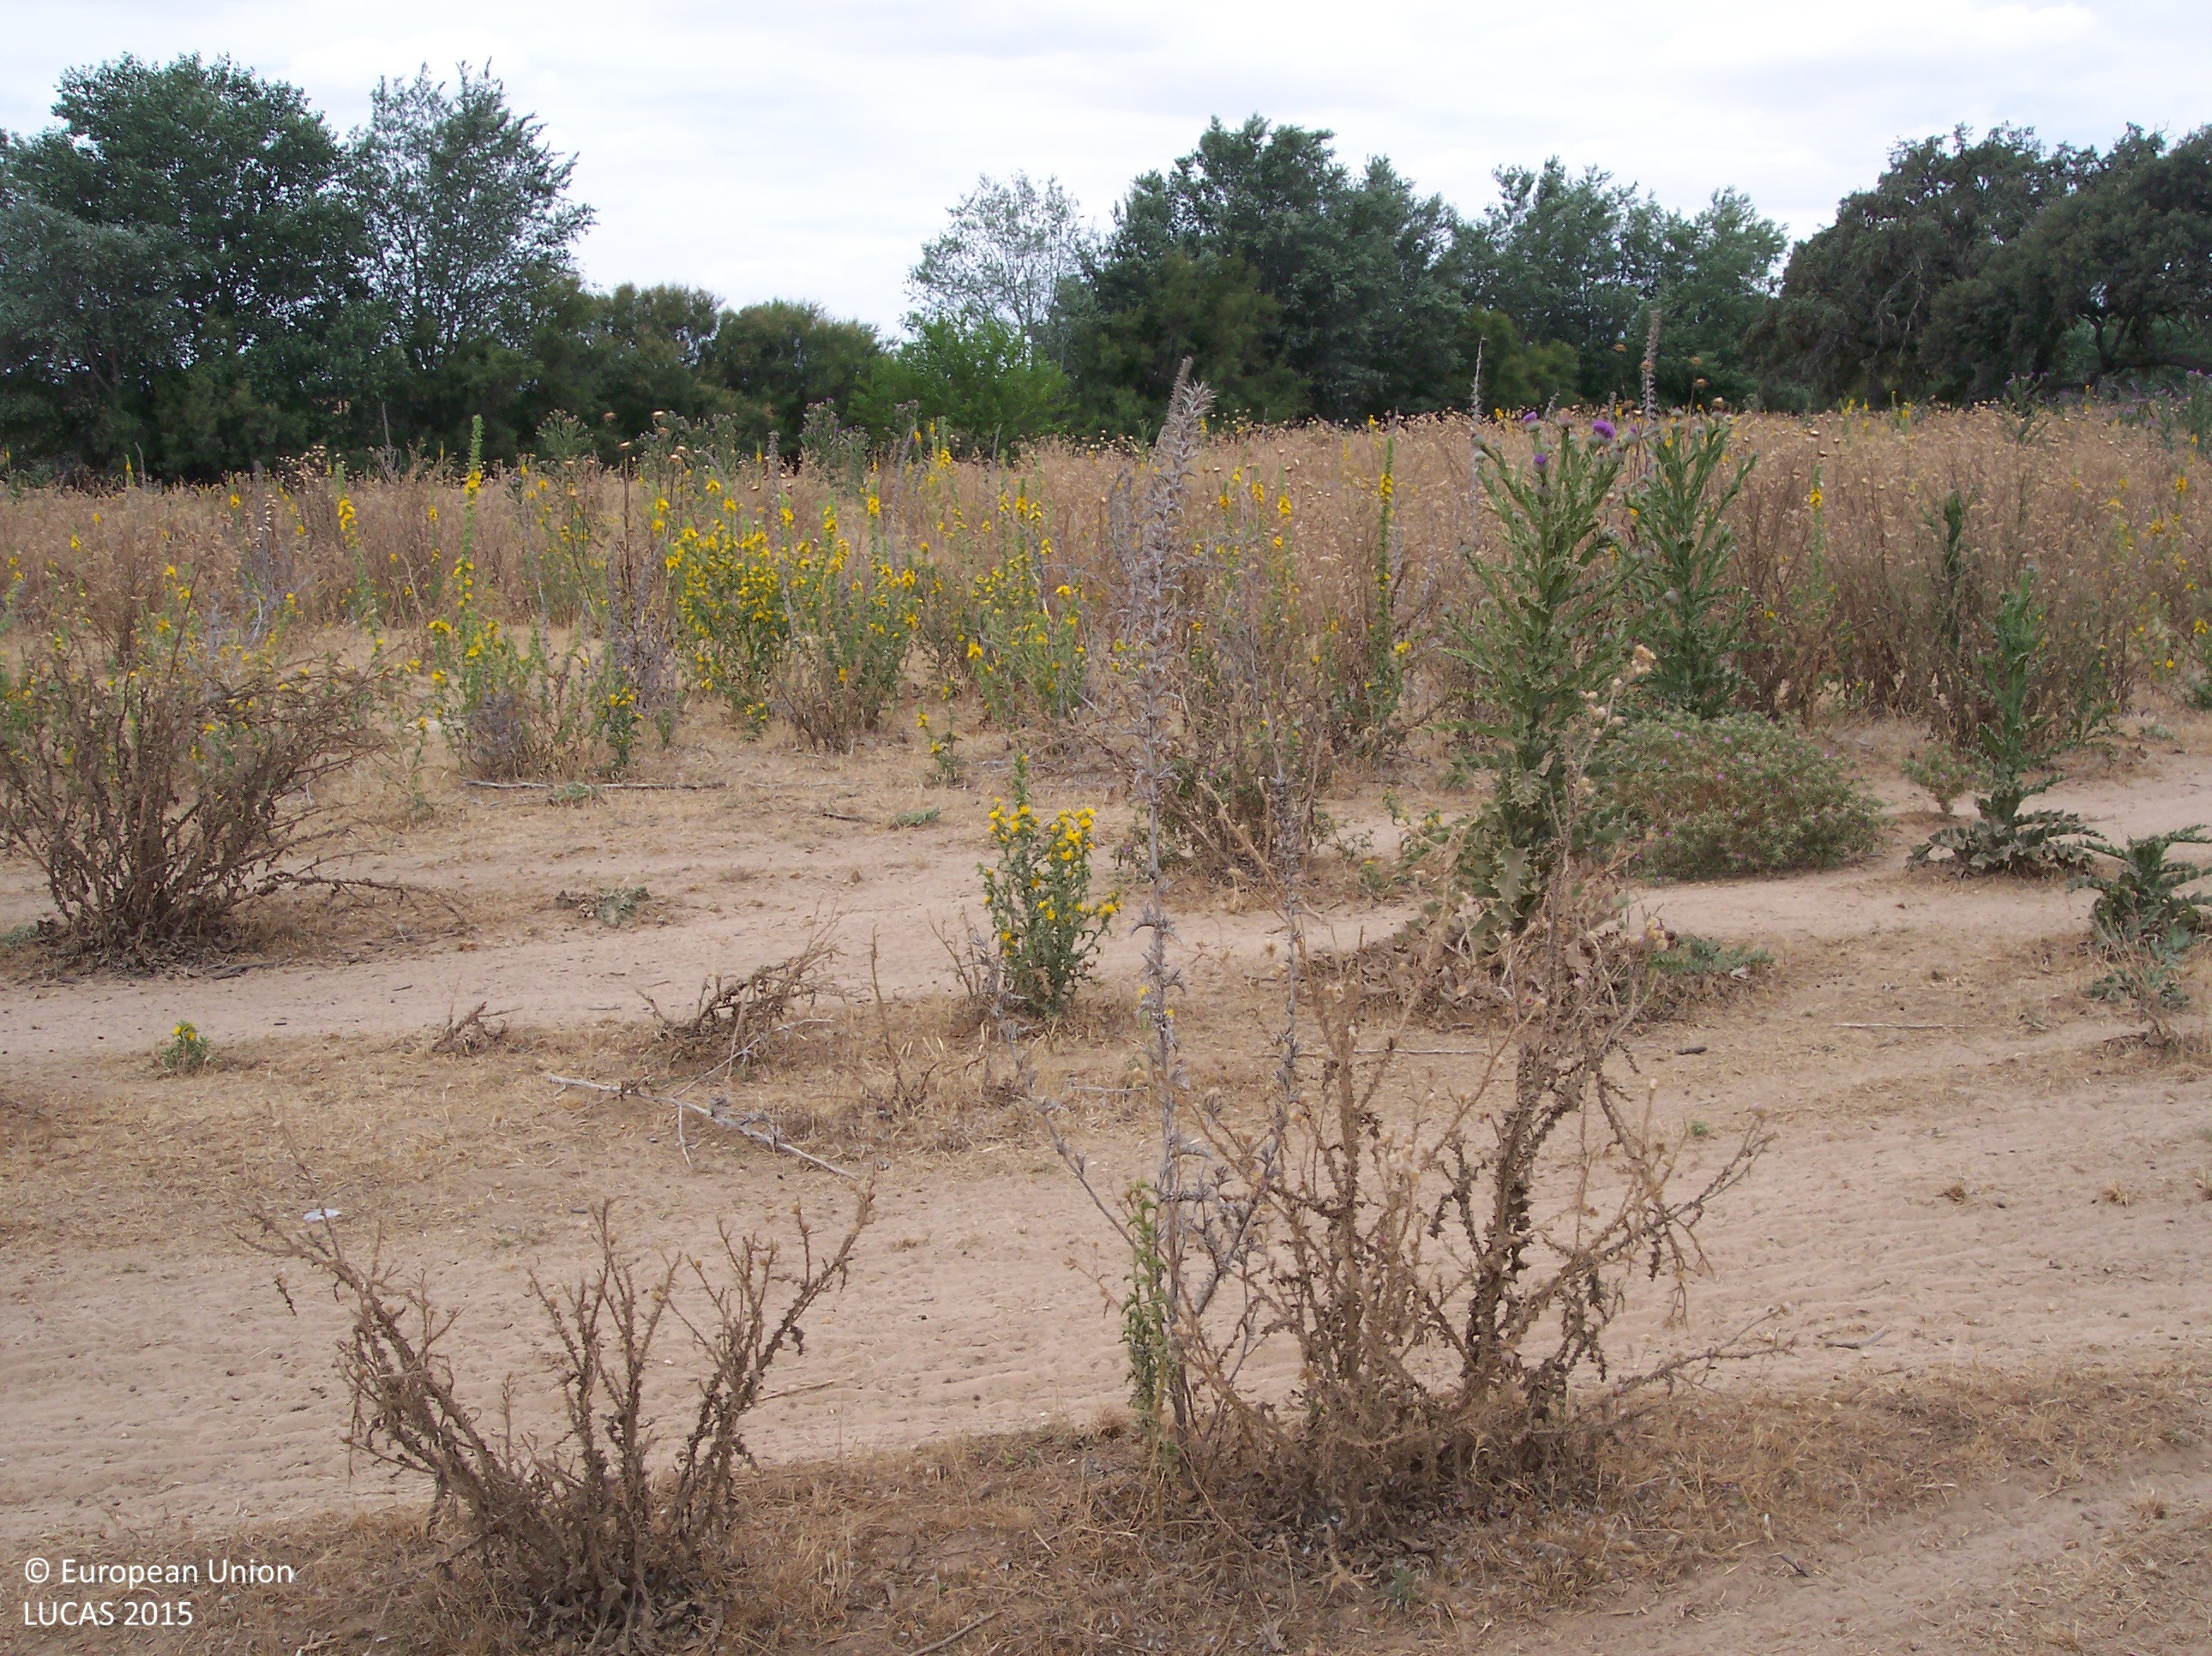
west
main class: Shrubland
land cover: Shrubland with sparse tree cover
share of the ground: 25 - 50 %
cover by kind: unconsolidated bare surface 60 %, shrubs 20 %, herbaceous plants 15 %, broadleaved forest trees 5 %
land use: Agriculture (excluding fallow land and kitchen gardens)
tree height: > 5 m
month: June
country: ES
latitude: 37.3273
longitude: -6.4049
